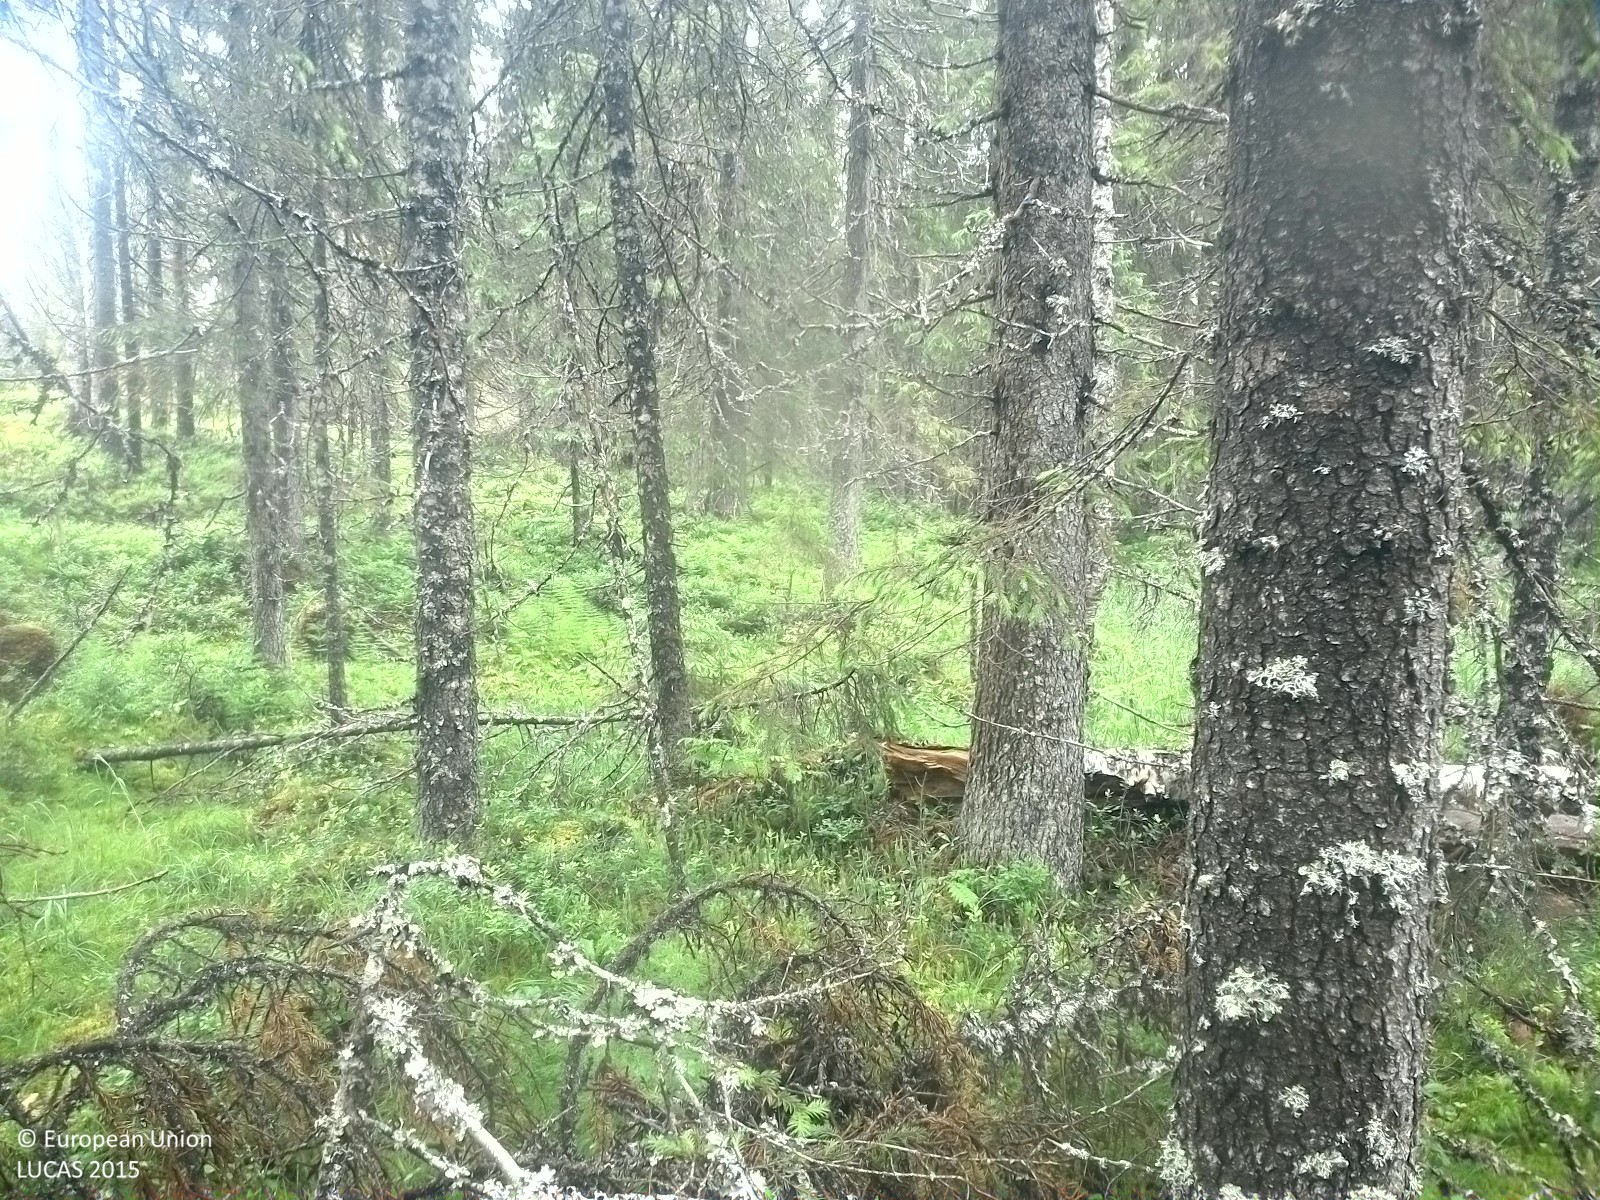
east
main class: Woodland
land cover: Spruce dominated coniferous woodland
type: boreal forest
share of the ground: 25 - 50 %
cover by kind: coniferous forest trees 40 %, lichens and mosses 40 %, herbaceous plants 15 %, broadleaved forest trees 5 %
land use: Forestry
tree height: > 5 m
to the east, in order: Spruce dominated coniferous woodland; Rivers and streams; Spruce dominated coniferous woodland; Tracks; Spruce dominated coniferous woodland; Grassland without tree/shrub cover; Rivers and streams; Grassland without tree/shrub cover
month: July
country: SE
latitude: 62.4560
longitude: 16.8609
